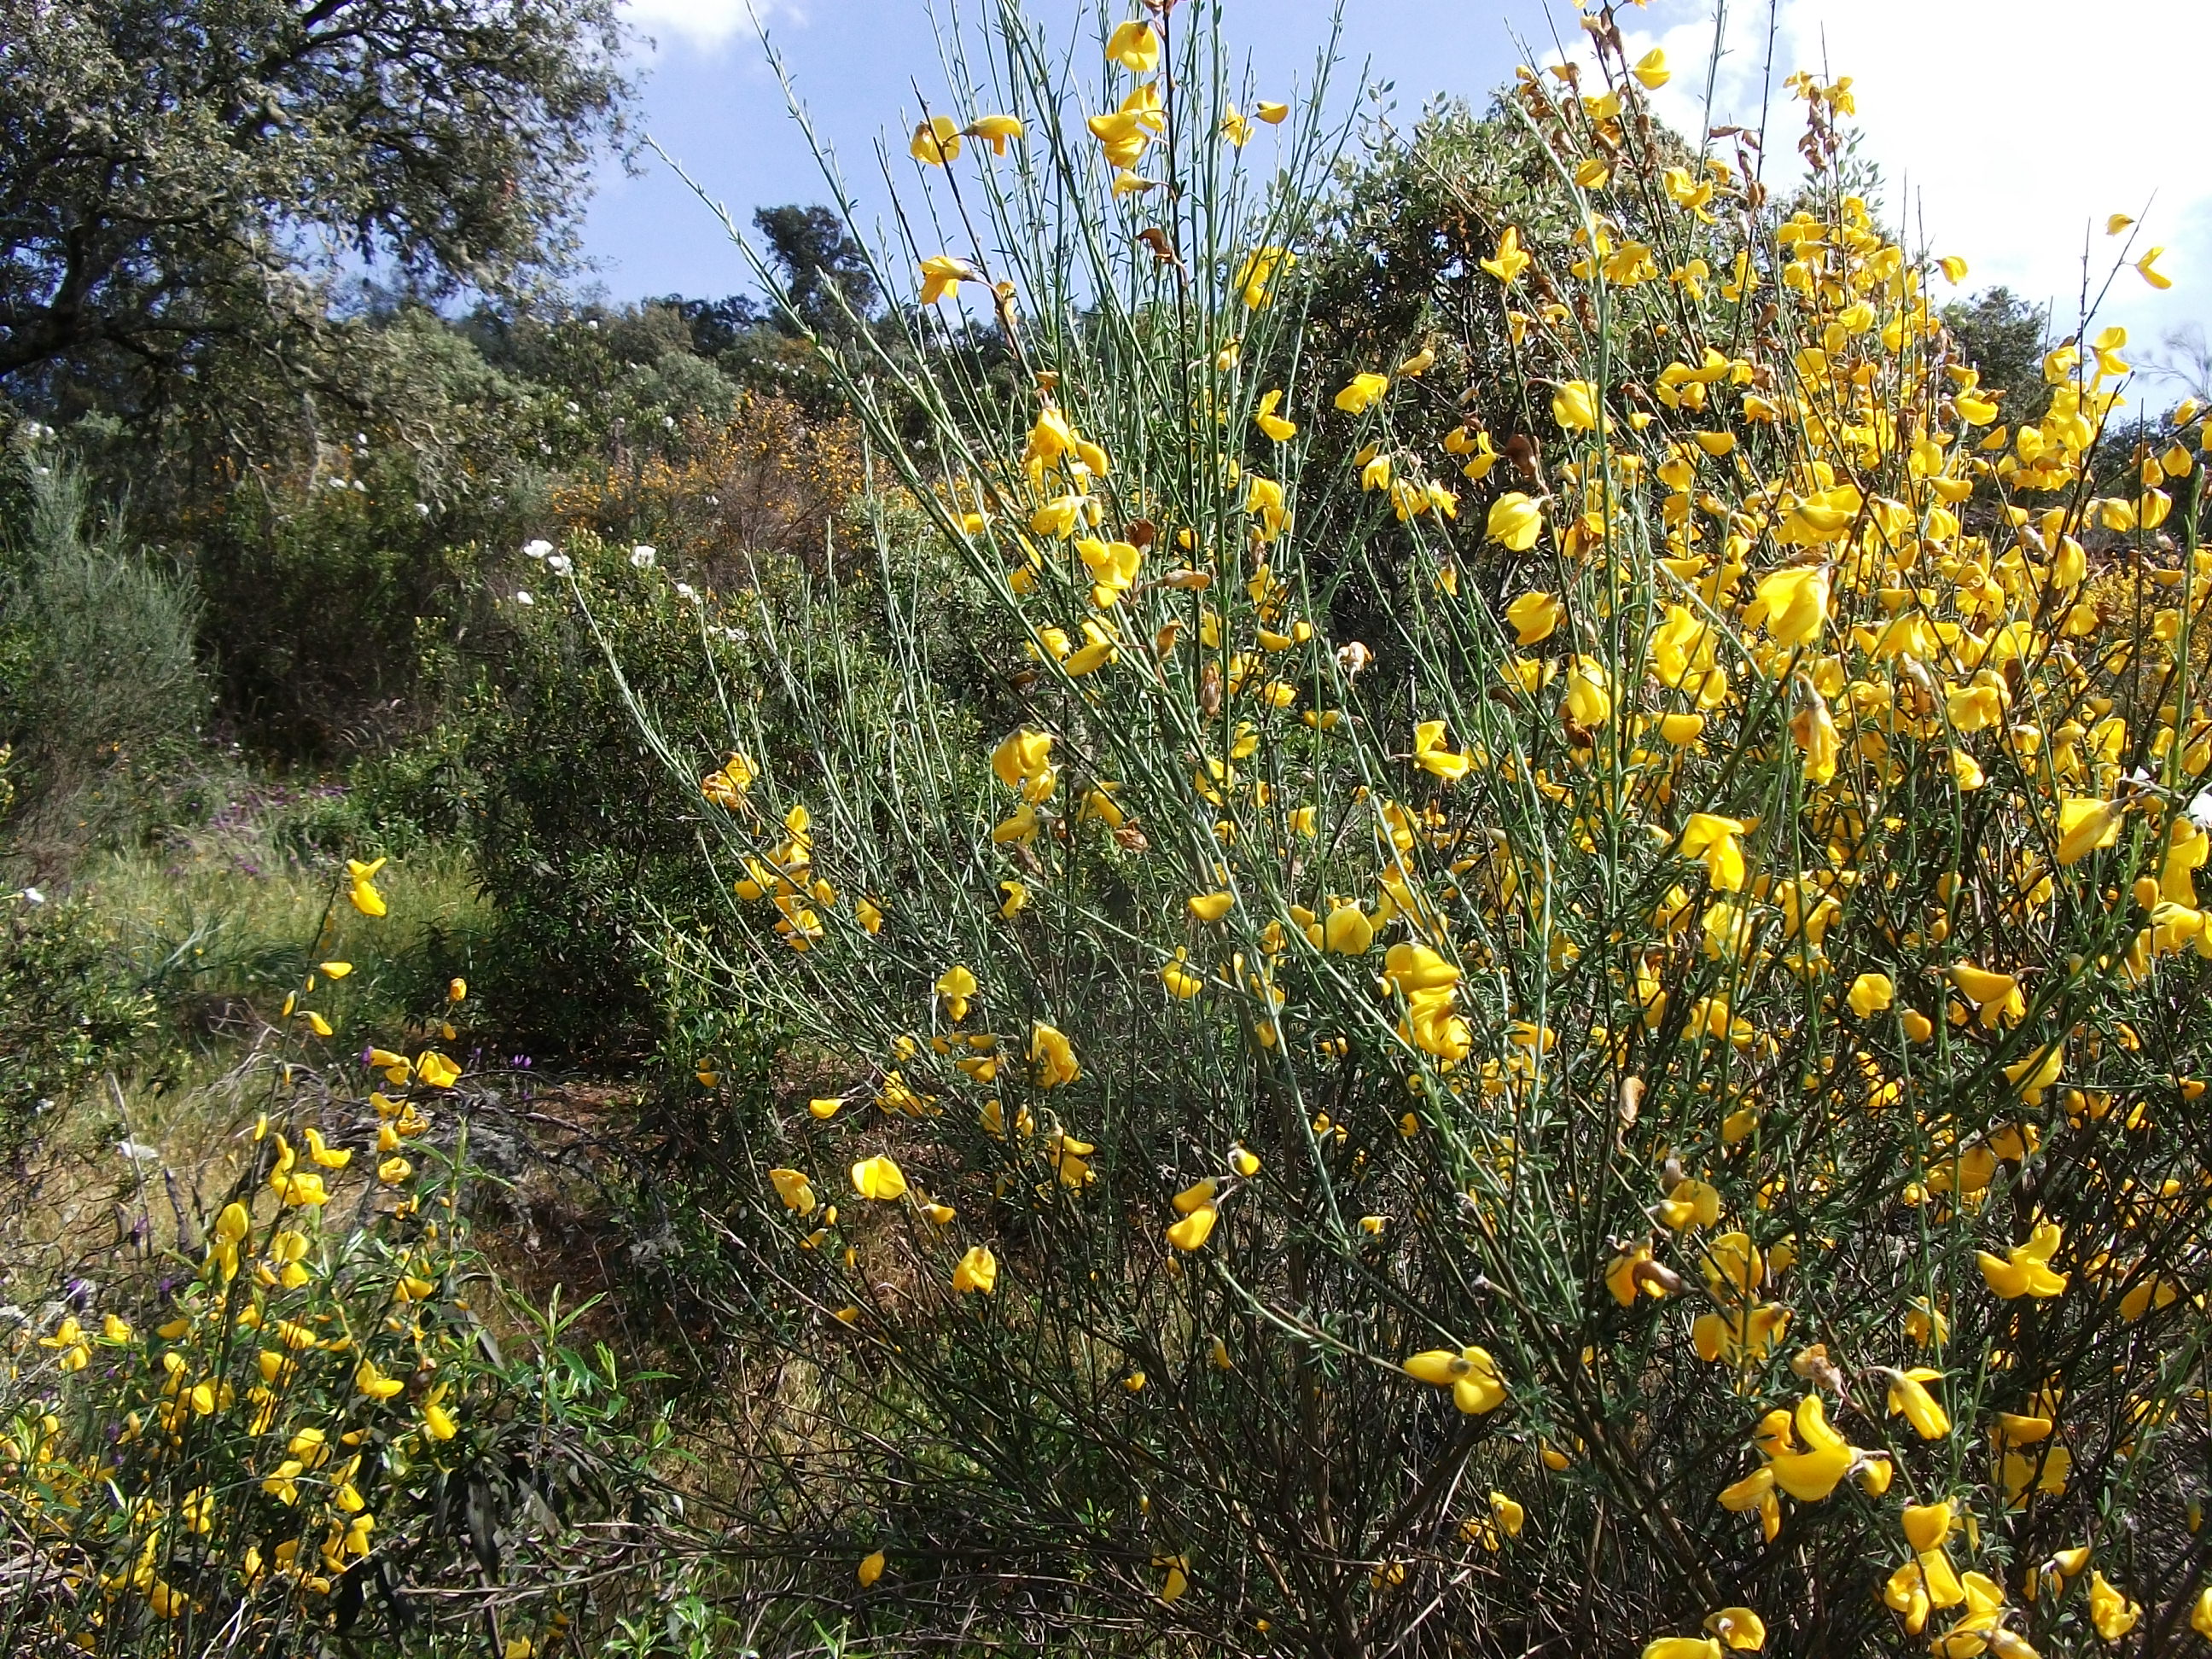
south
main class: Woodland
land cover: Broadleaved woodland
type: broadleaved evergreen forest
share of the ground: 25 - 50 %
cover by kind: shrubs 60 %, broadleaved forest trees 35 %, herbaceous plants 5 %
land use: Semi-natural and natural areas not in use
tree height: > 5 m
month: April
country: ES
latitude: 38.0738
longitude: -6.7738
